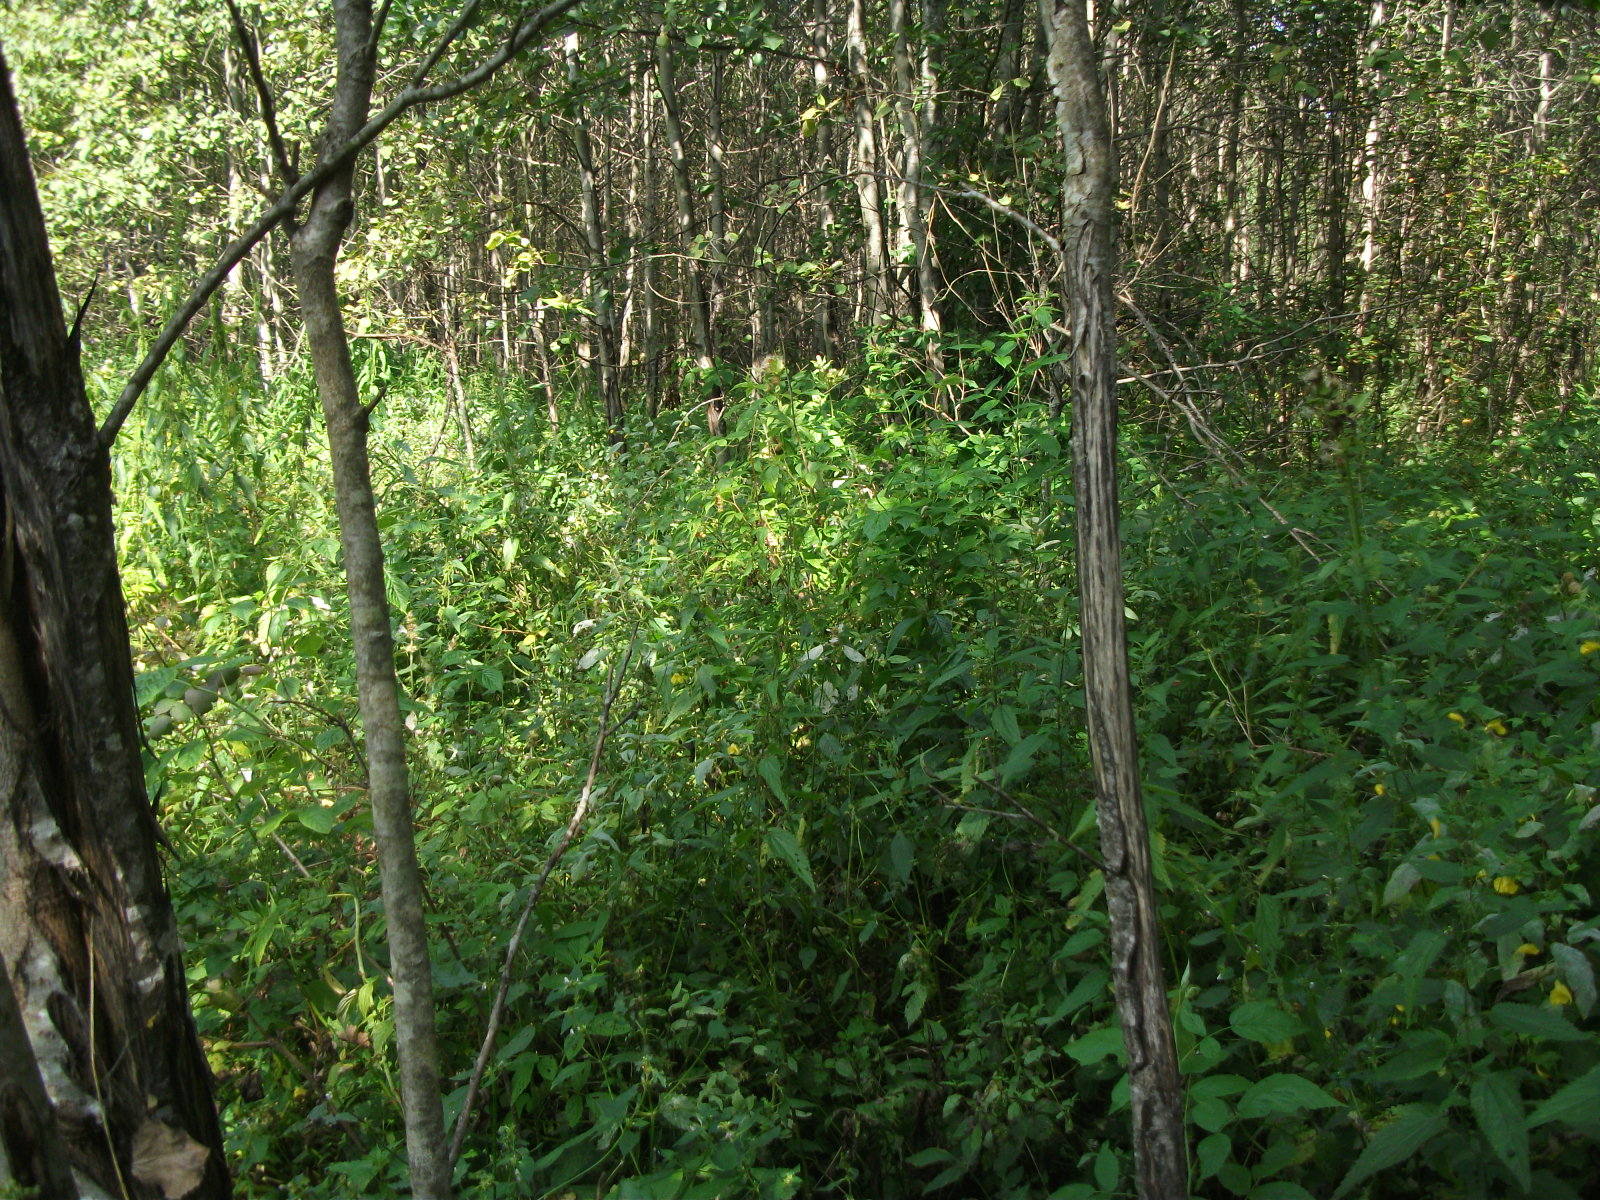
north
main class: Woodland
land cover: Broadleaved woodland
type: non-riverine alder, birch or aspen forest
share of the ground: 50 - 75 %
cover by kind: broadleaved forest trees 70 %, herbaceous plants 20 %, shrubs 10 %
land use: Forestry
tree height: > 5 m
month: August
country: LV
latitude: 56.8697
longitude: 26.4008
